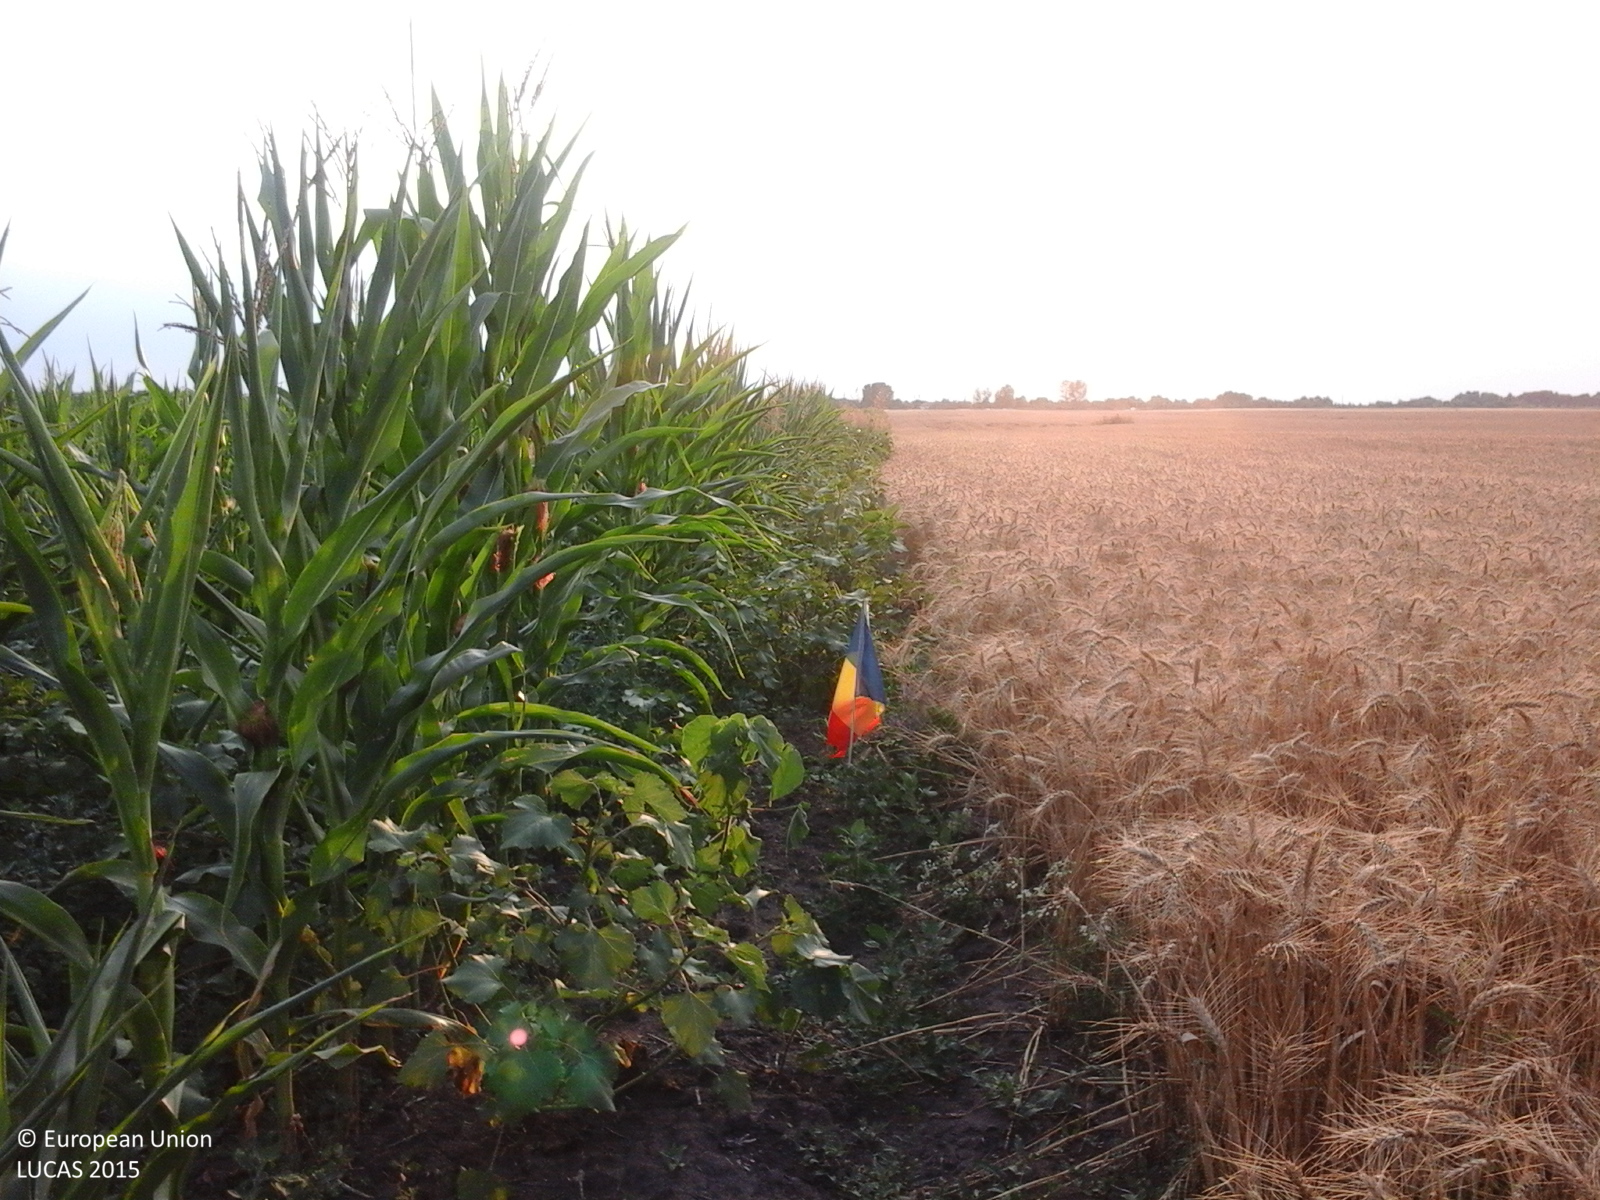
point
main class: Cropland
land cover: Common wheat
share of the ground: > 75 %
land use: Agriculture (excluding fallow land and kitchen gardens)
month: July
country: RO
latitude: 43.7198
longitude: 24.1710
